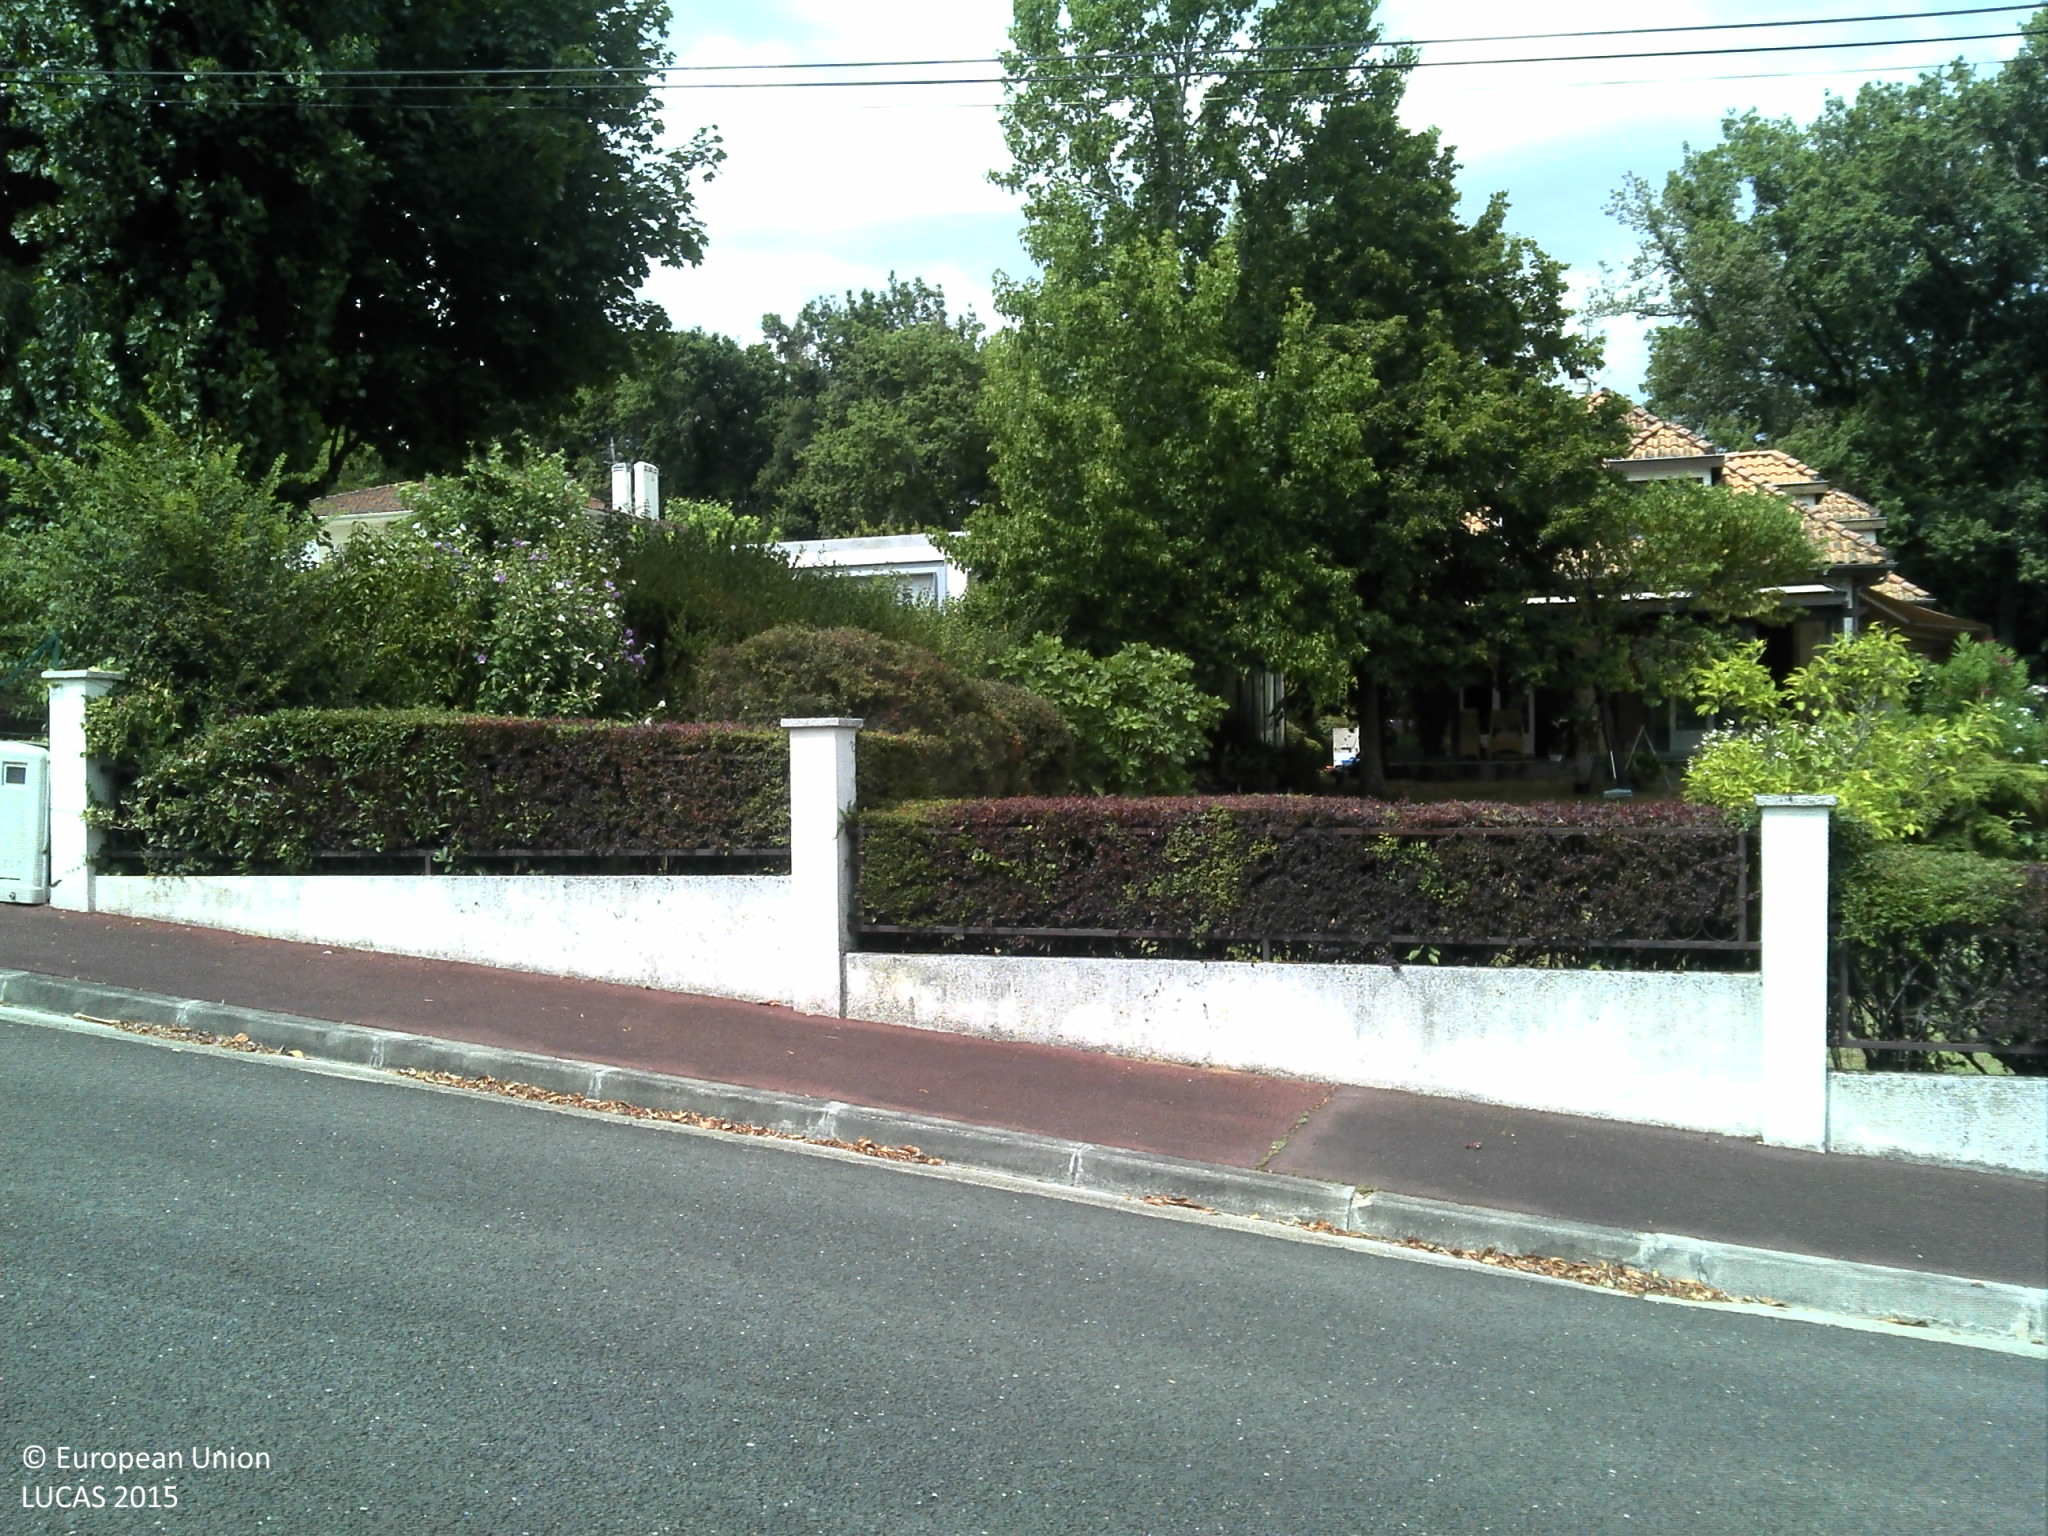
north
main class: Grassland
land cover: Grassland with sparse tree/shrub cover
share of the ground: > 75 %
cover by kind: herbaceous plants 85 %, unconsolidated bare surface 10 %, broadleaved forest trees 5 %
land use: Residential
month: July
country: FR
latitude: 44.8158
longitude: -0.5007
